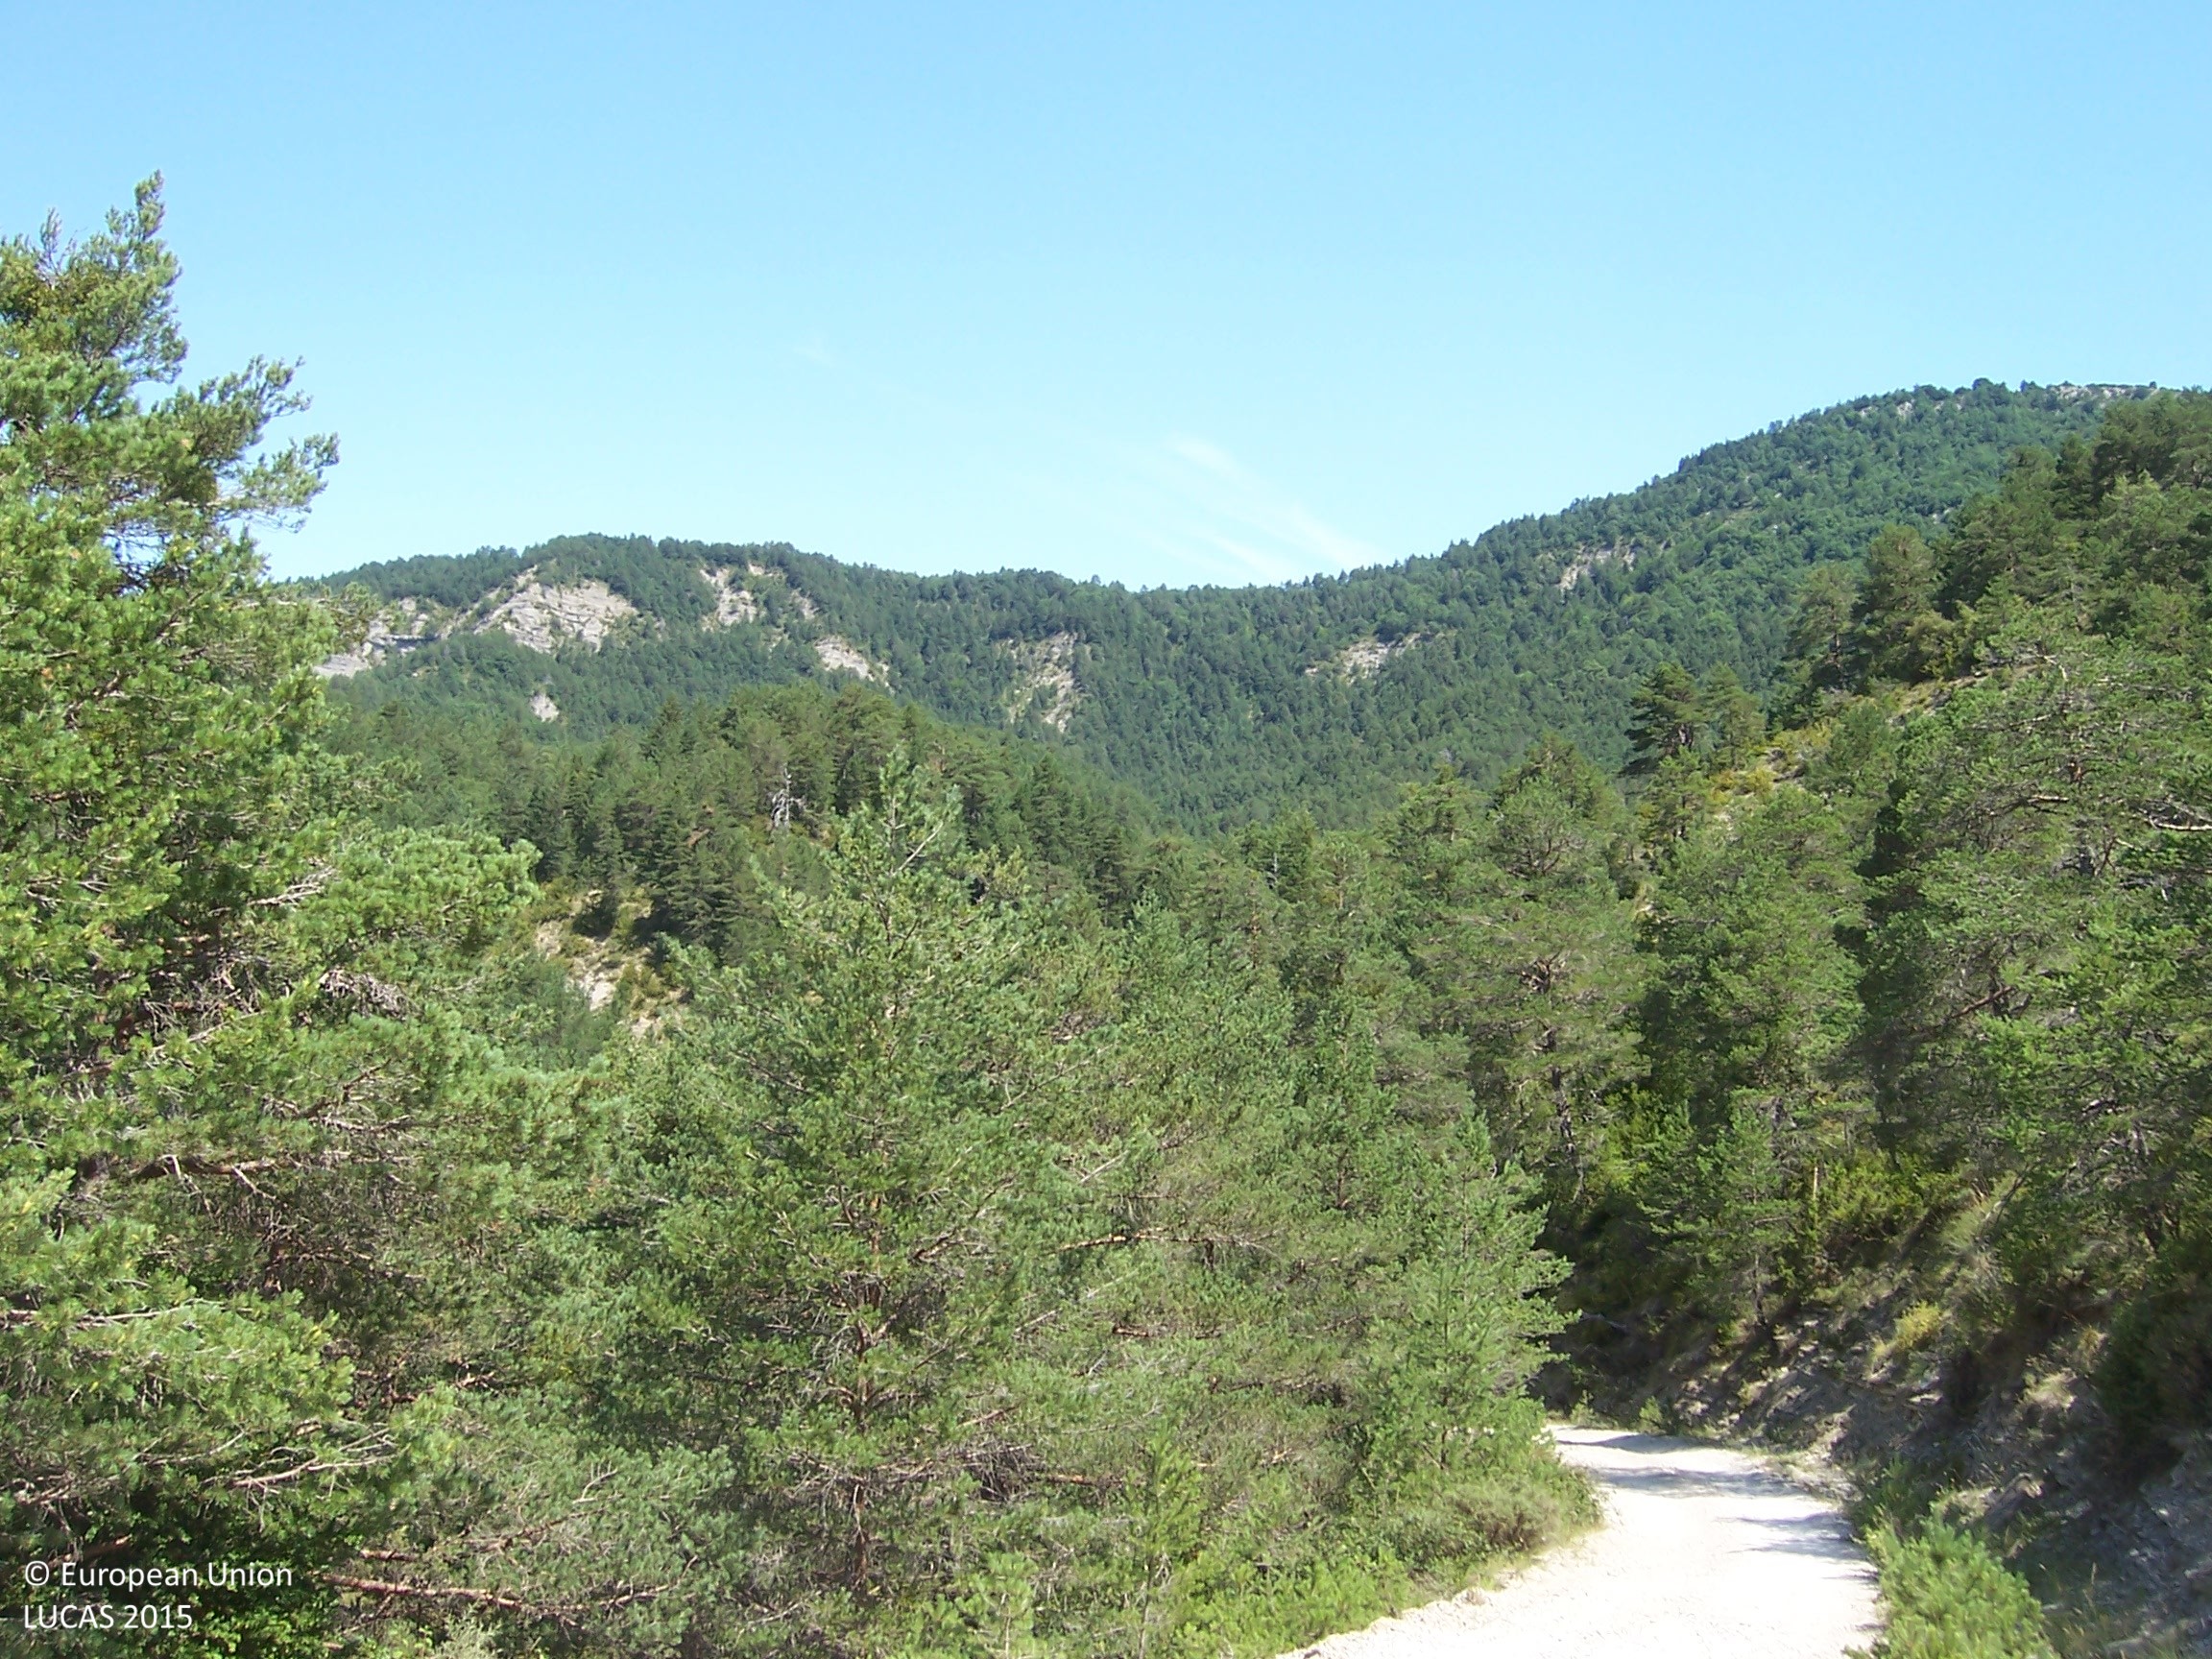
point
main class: Woodland
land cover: Pine dominated coniferous woodland
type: coniferous forest of the mediterranean region
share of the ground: > 75 %
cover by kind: coniferous forest trees 100 %
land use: Forestry
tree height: > 5 m
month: July
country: ES
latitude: 42.8317
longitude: -1.2040
